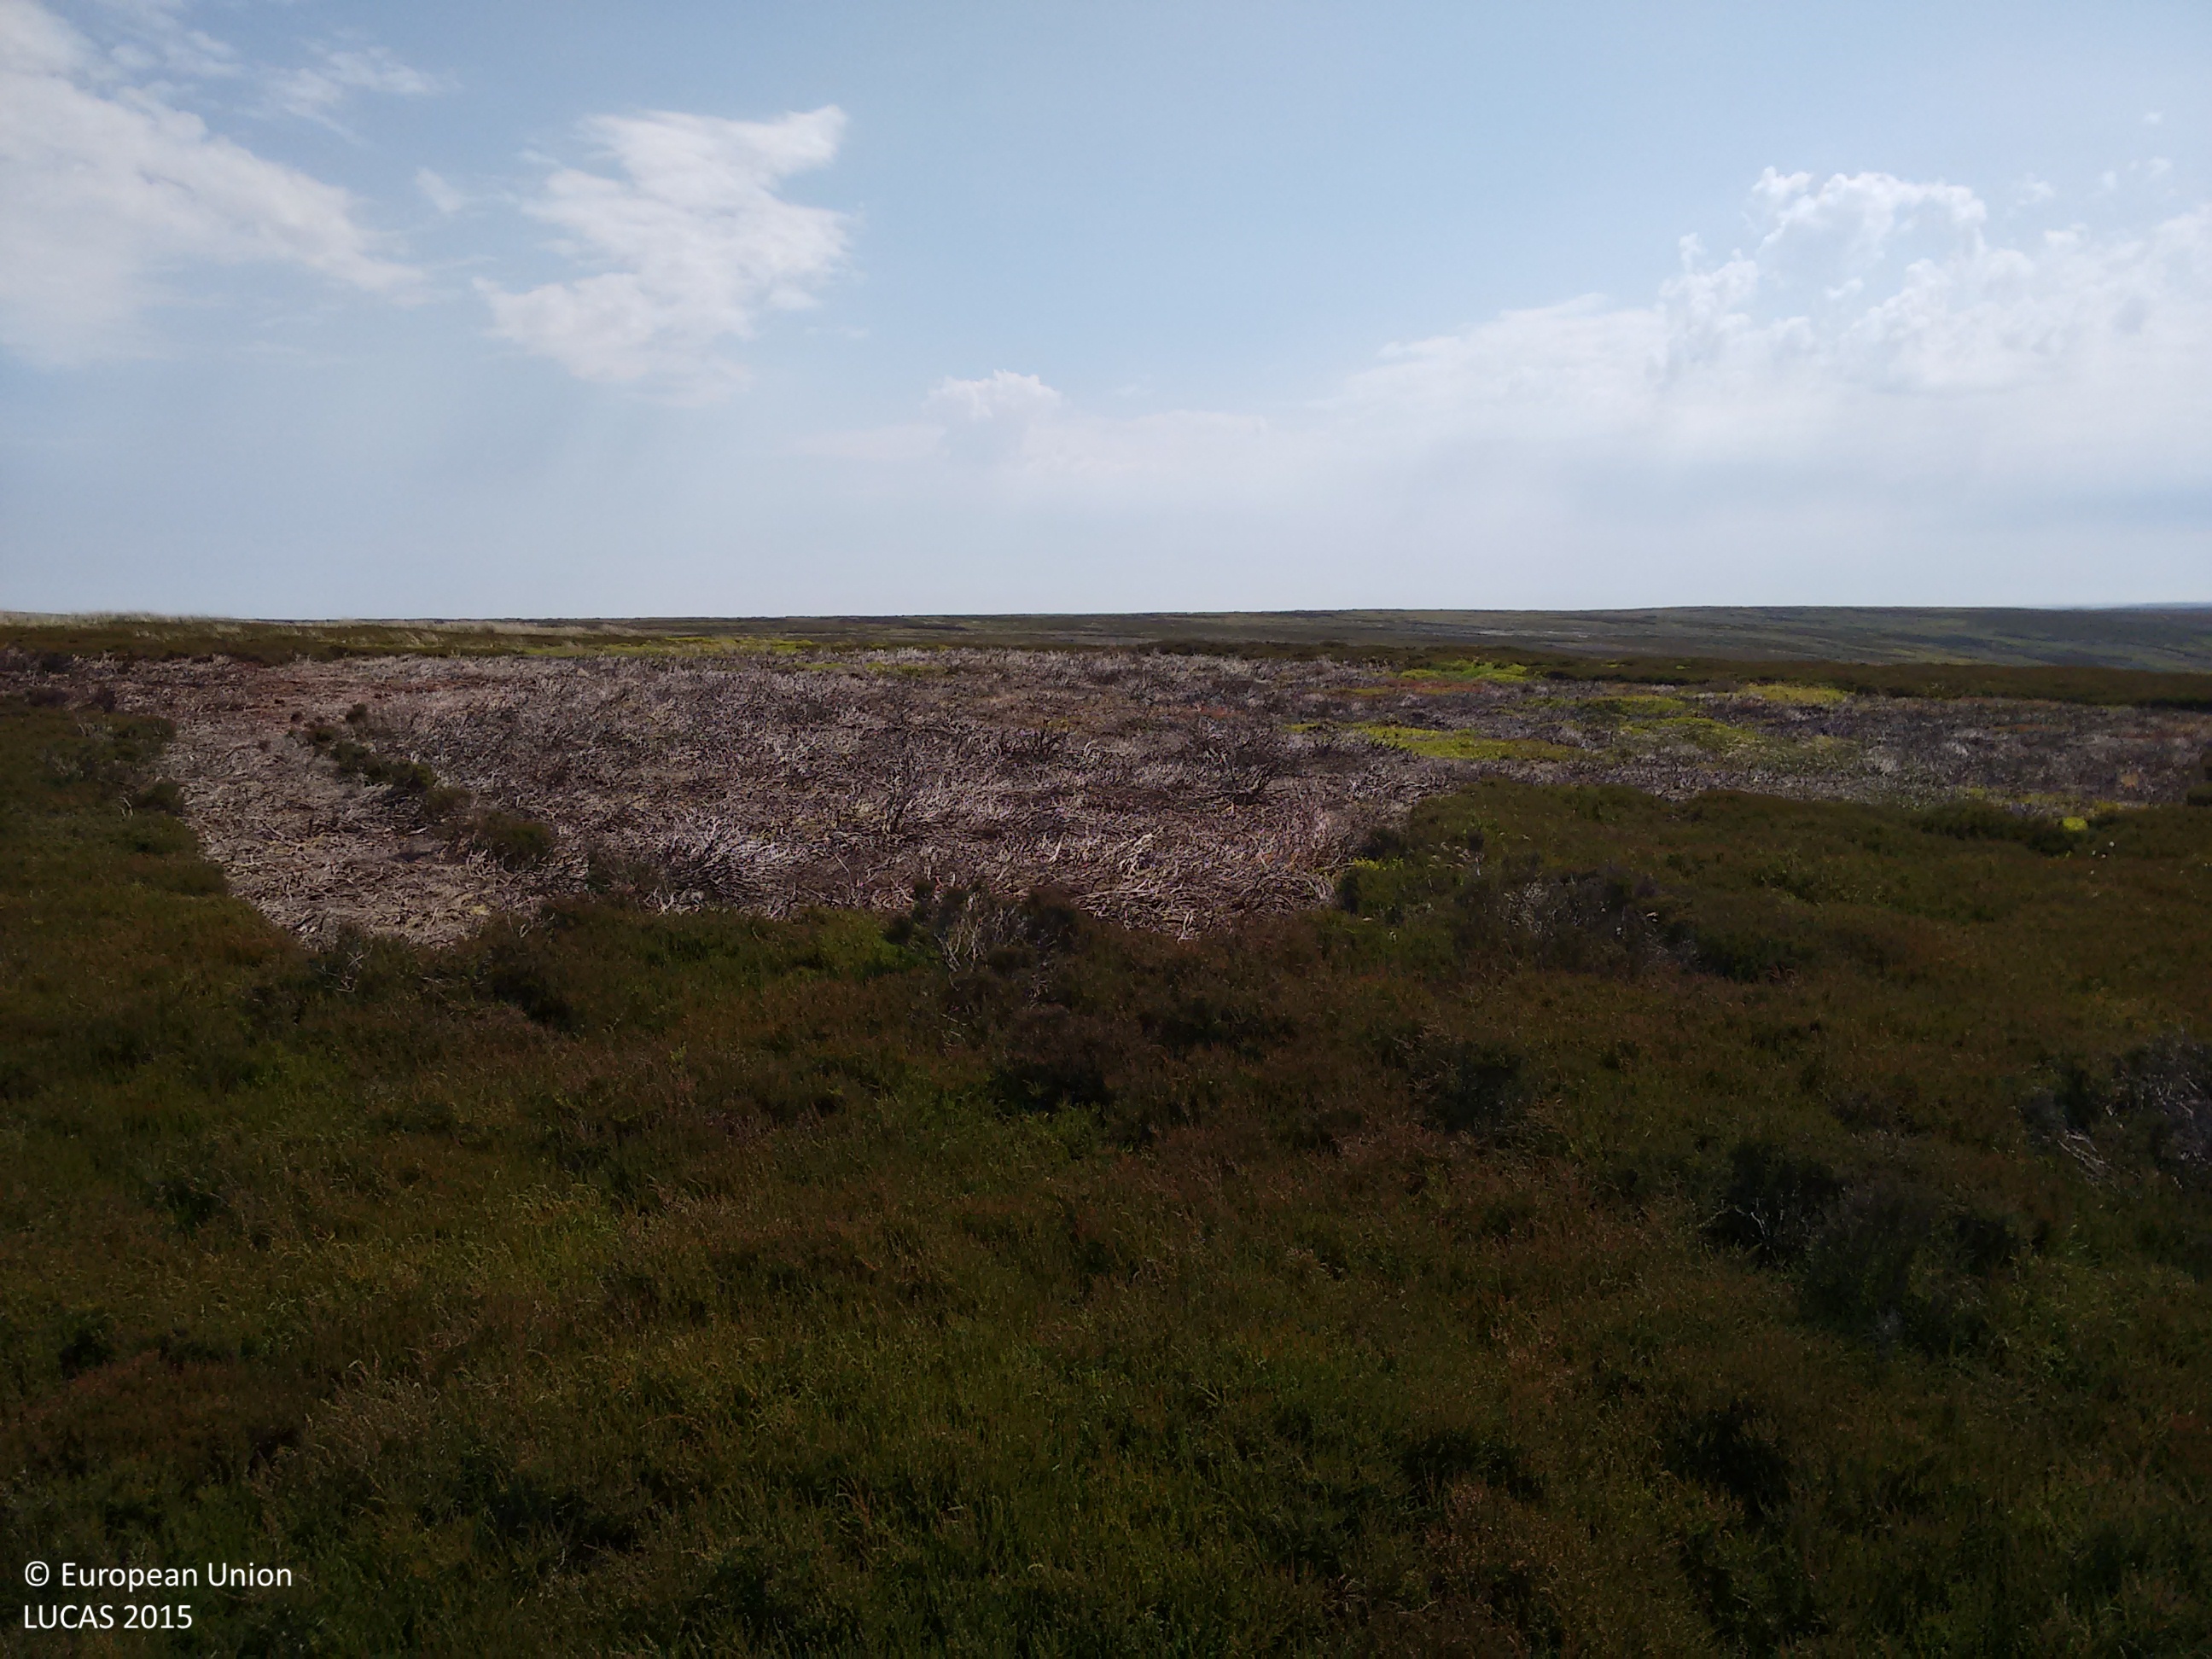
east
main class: Shrubland
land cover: Shrubland without tree cover
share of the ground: > 75 %
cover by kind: shrubs 100 %
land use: Semi-natural and natural areas not in use
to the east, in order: Shrubland without tree cover; Tracks; Shrubland without tree cover
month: July
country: GB
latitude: 54.3940
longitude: -0.9299
